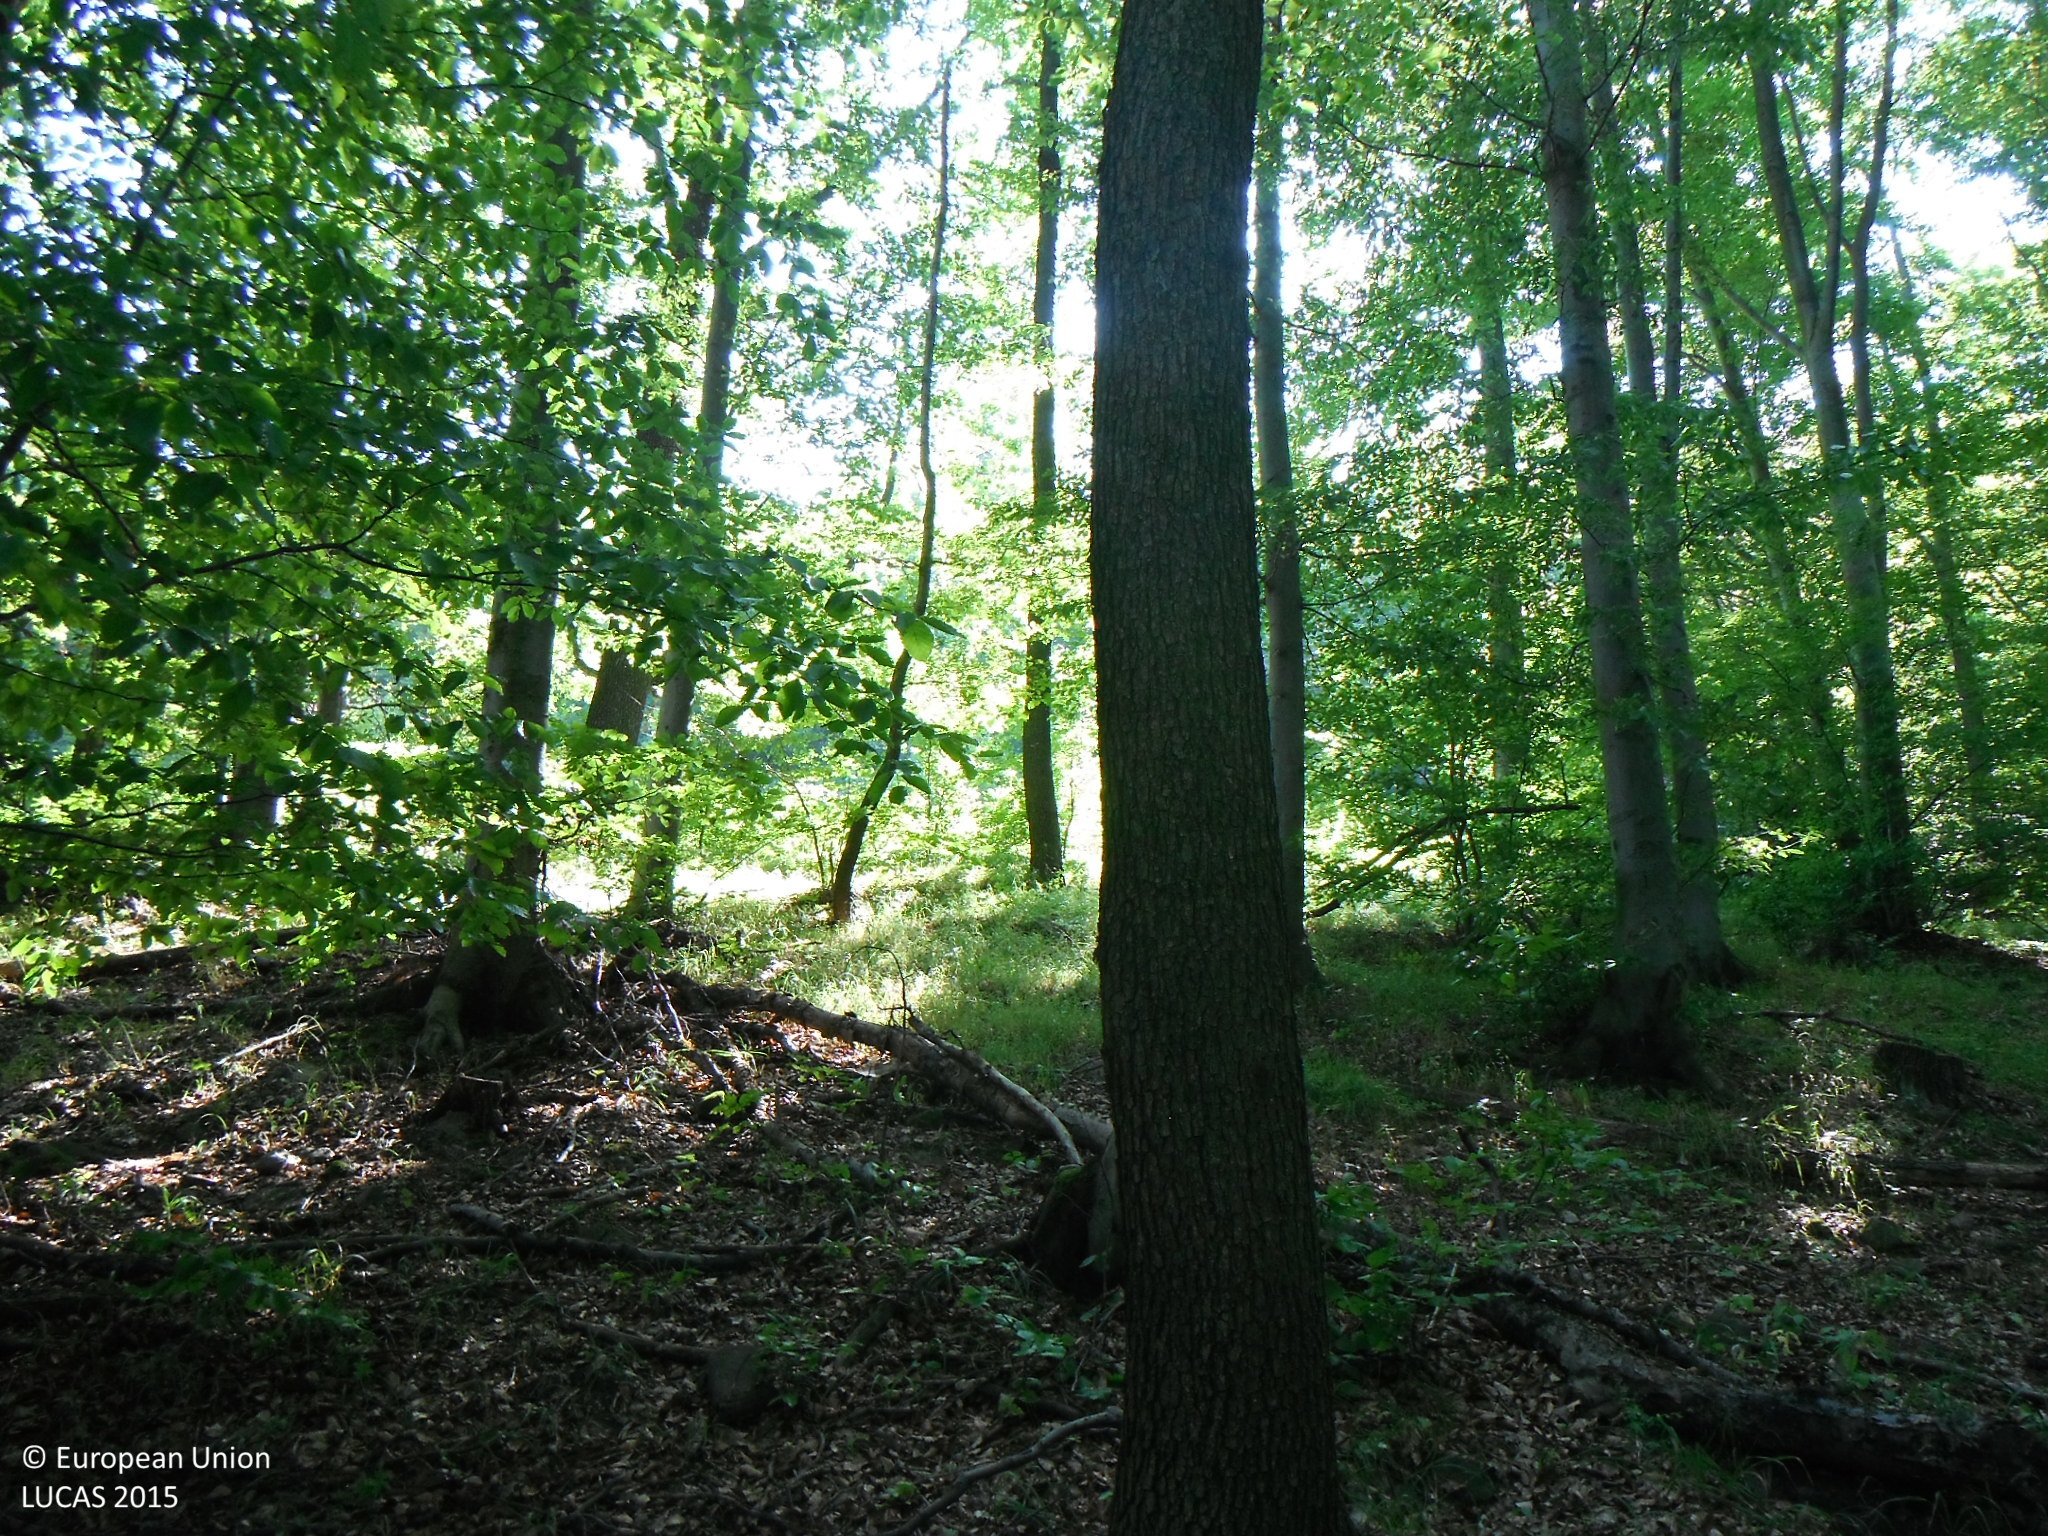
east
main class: Woodland
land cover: Broadleaved woodland
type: beech forest
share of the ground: > 75 %
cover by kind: broadleaved forest trees 95 %, herbaceous plants 5 %
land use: Forestry
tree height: > 5 m
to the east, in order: Broadleaved woodland; Shrubland without tree cover; Tracks; Broadleaved woodland; Spruce dominated mixed woodland
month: July
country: SK
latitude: 48.3993
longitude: 18.7575
